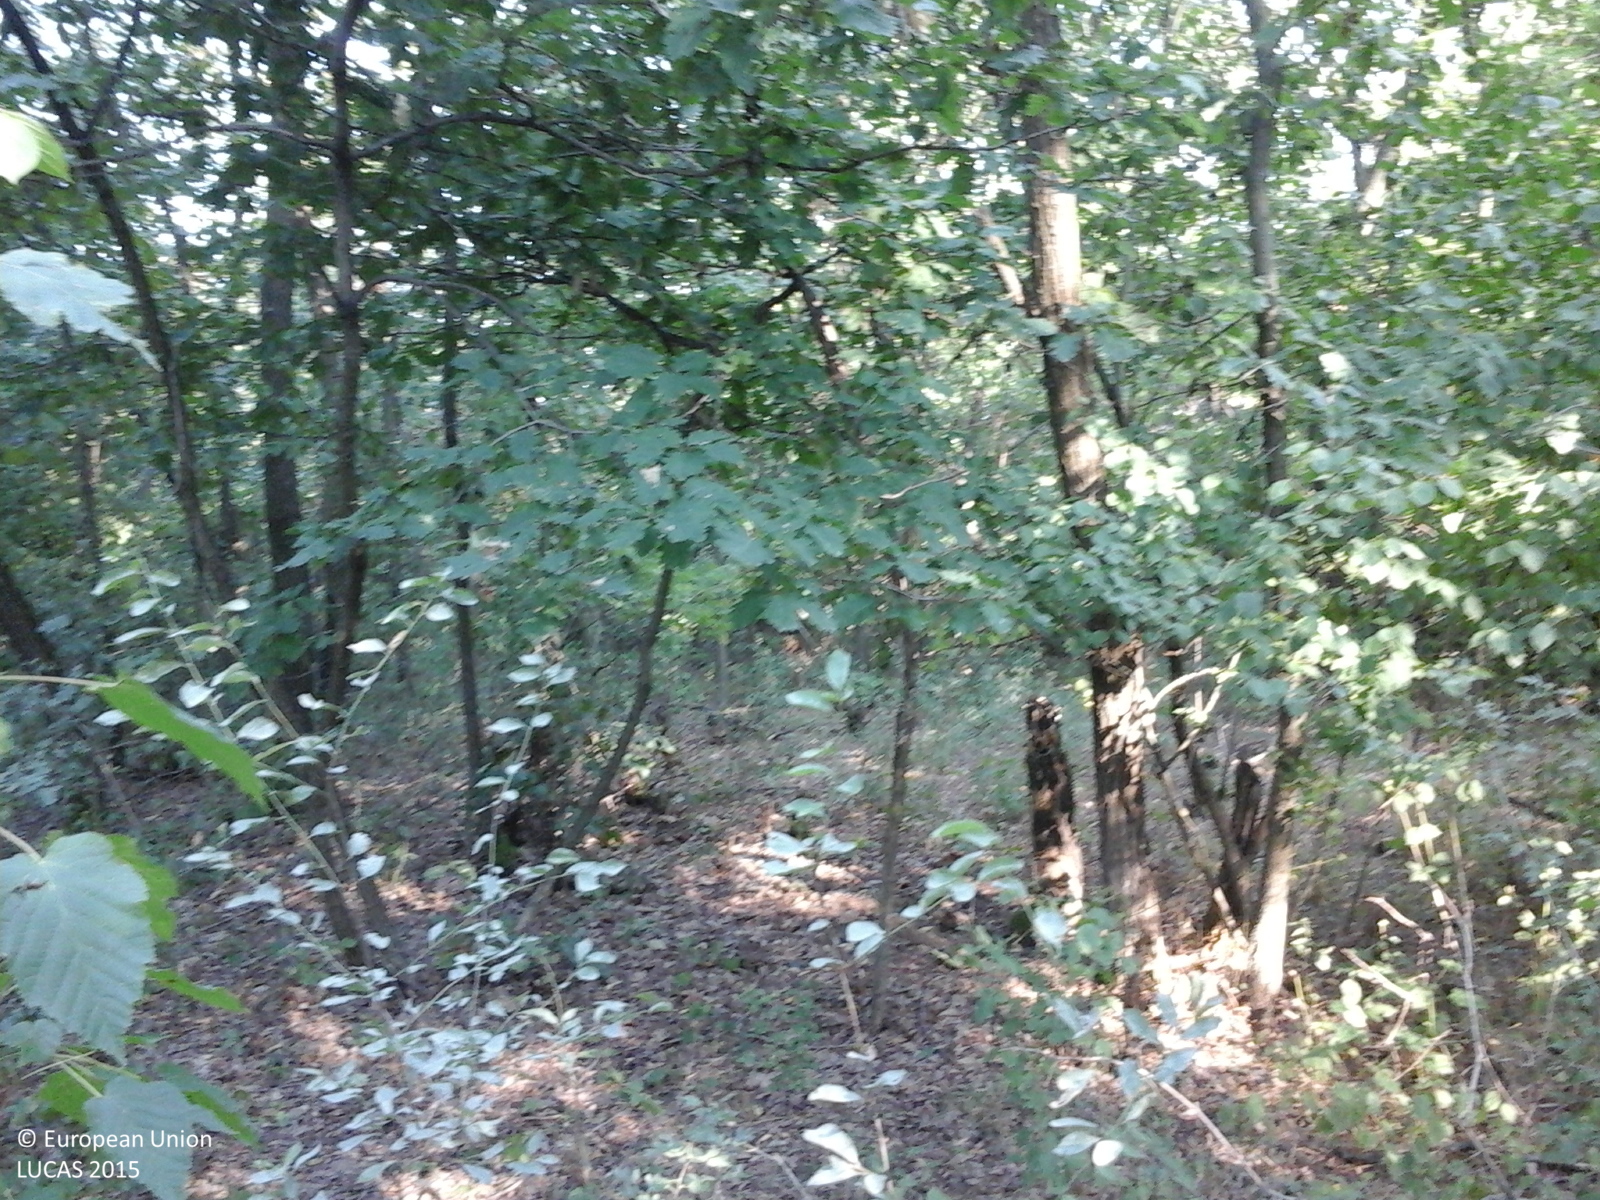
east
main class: Woodland
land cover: Broadleaved woodland
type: acidophilous oak and oak-birch forest
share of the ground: > 75 %
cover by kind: broadleaved forest trees 100 %
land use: Forestry
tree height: > 5 m
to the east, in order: Broadleaved woodland; Tracks; Grassland without tree/shrub cover; Tracks; Grass margins; Abandoned hedges; Grassland without tree/shrub cover
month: September
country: RO
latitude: 47.2483
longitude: 22.7030
